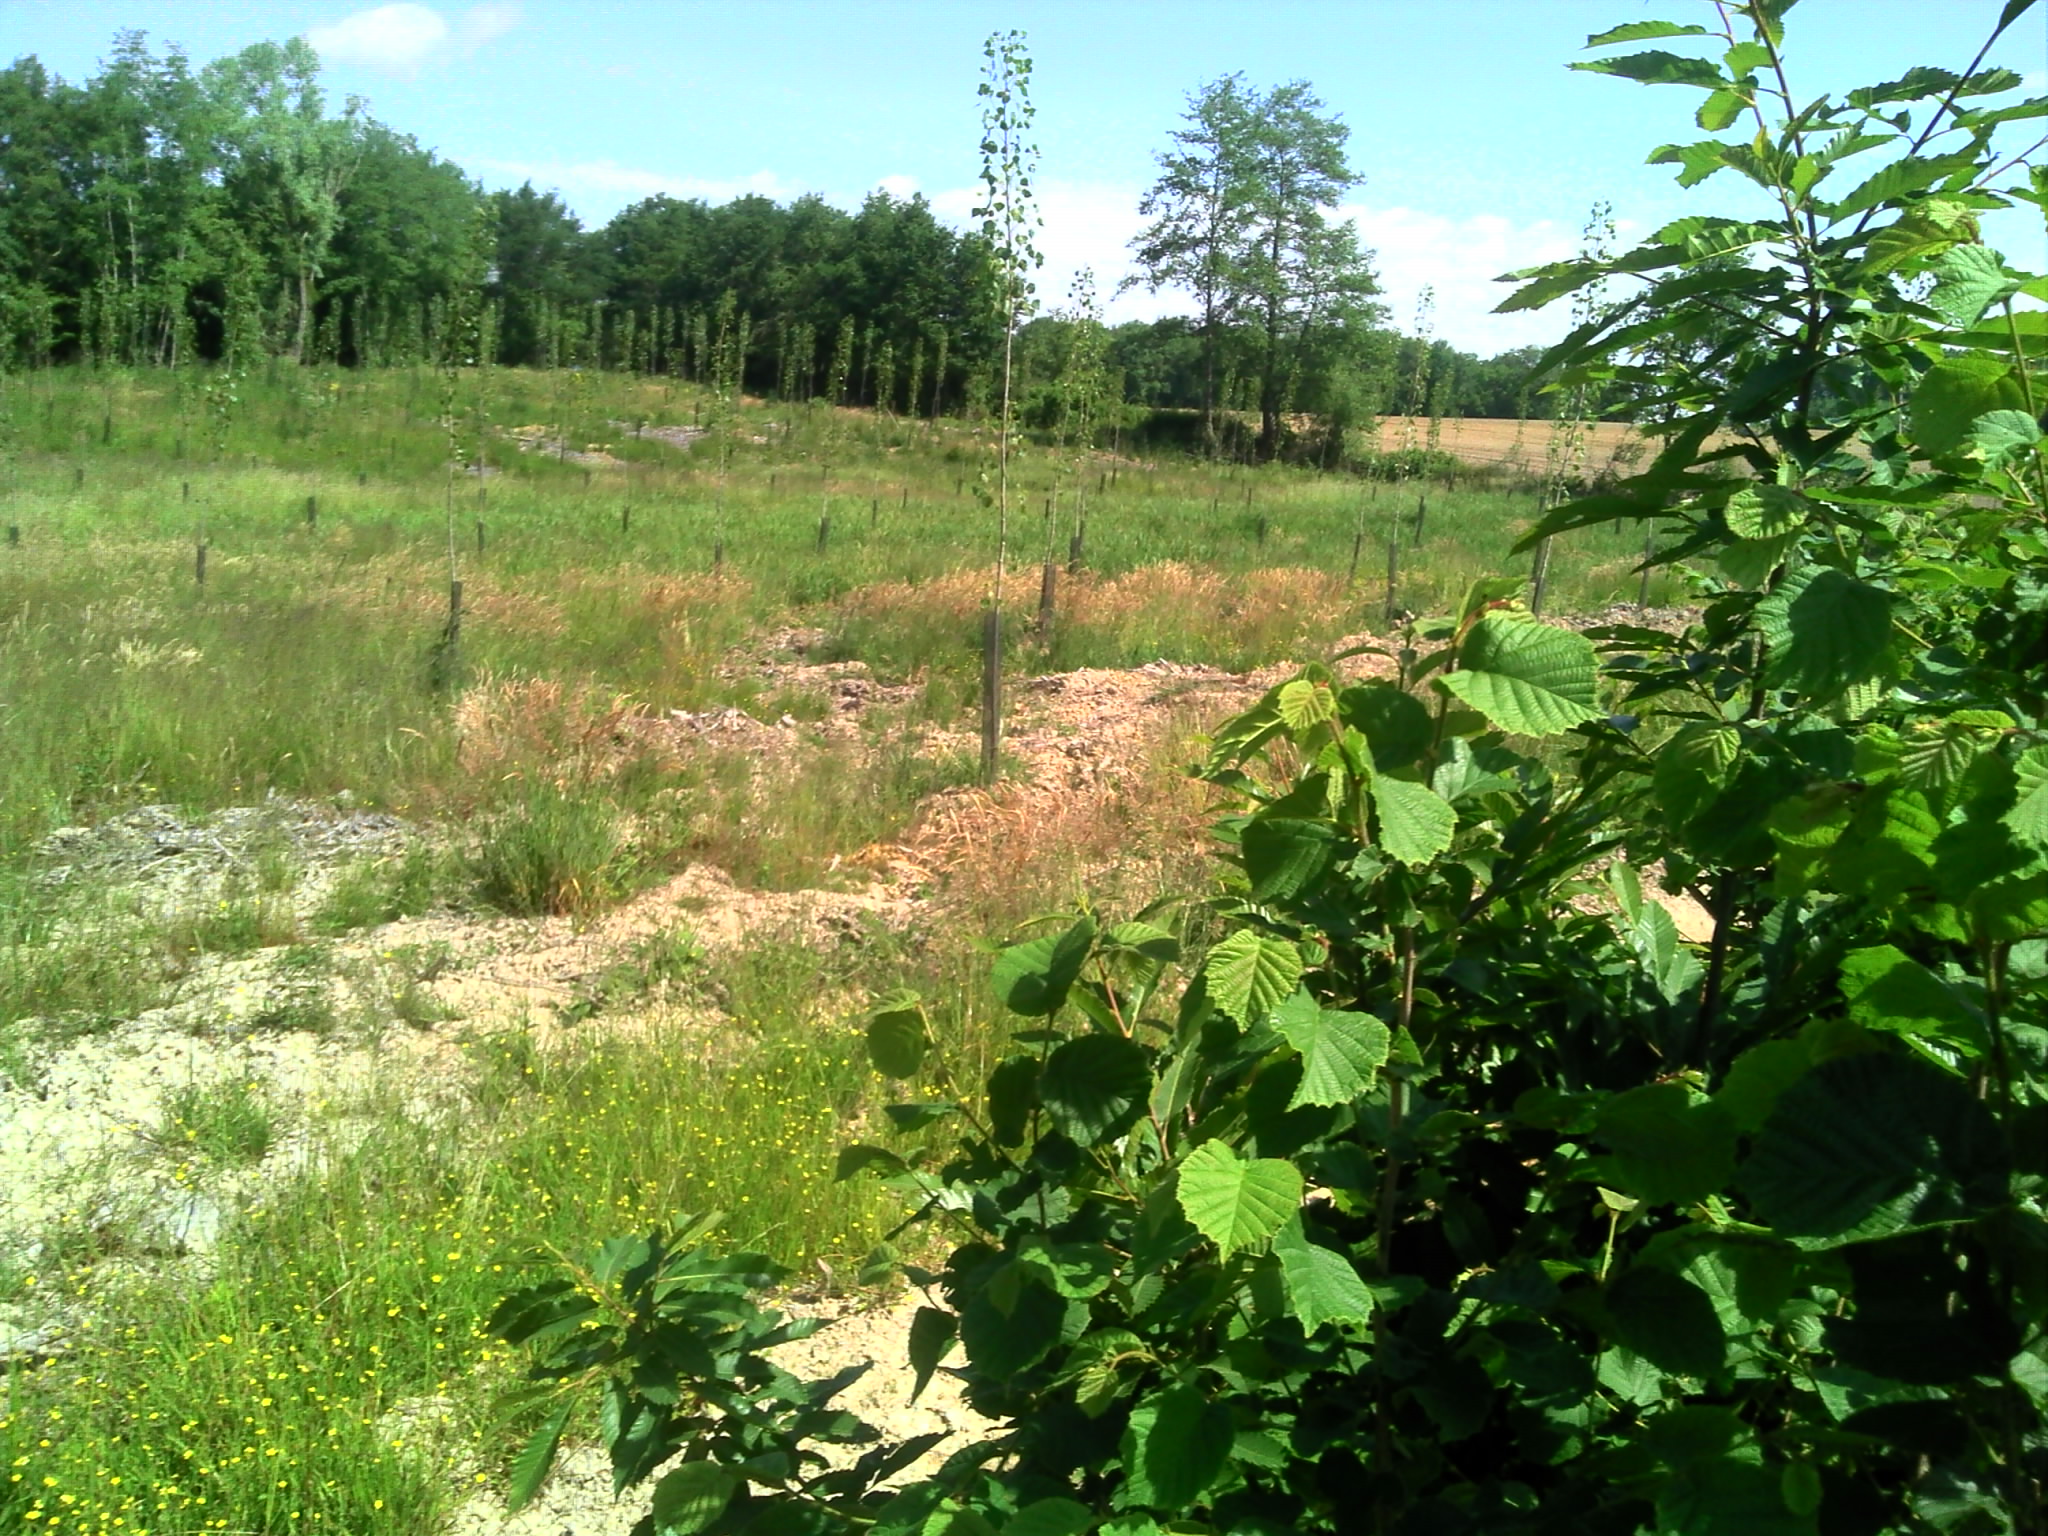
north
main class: Woodland
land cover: Broadleaved woodland
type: mesophytic deciduous forest
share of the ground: > 75 %
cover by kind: broadleaved forest trees 65 %, herbaceous plants 35 %
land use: Forestry
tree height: < 5 m
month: May
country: FR
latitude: 46.5965
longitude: 5.0286
